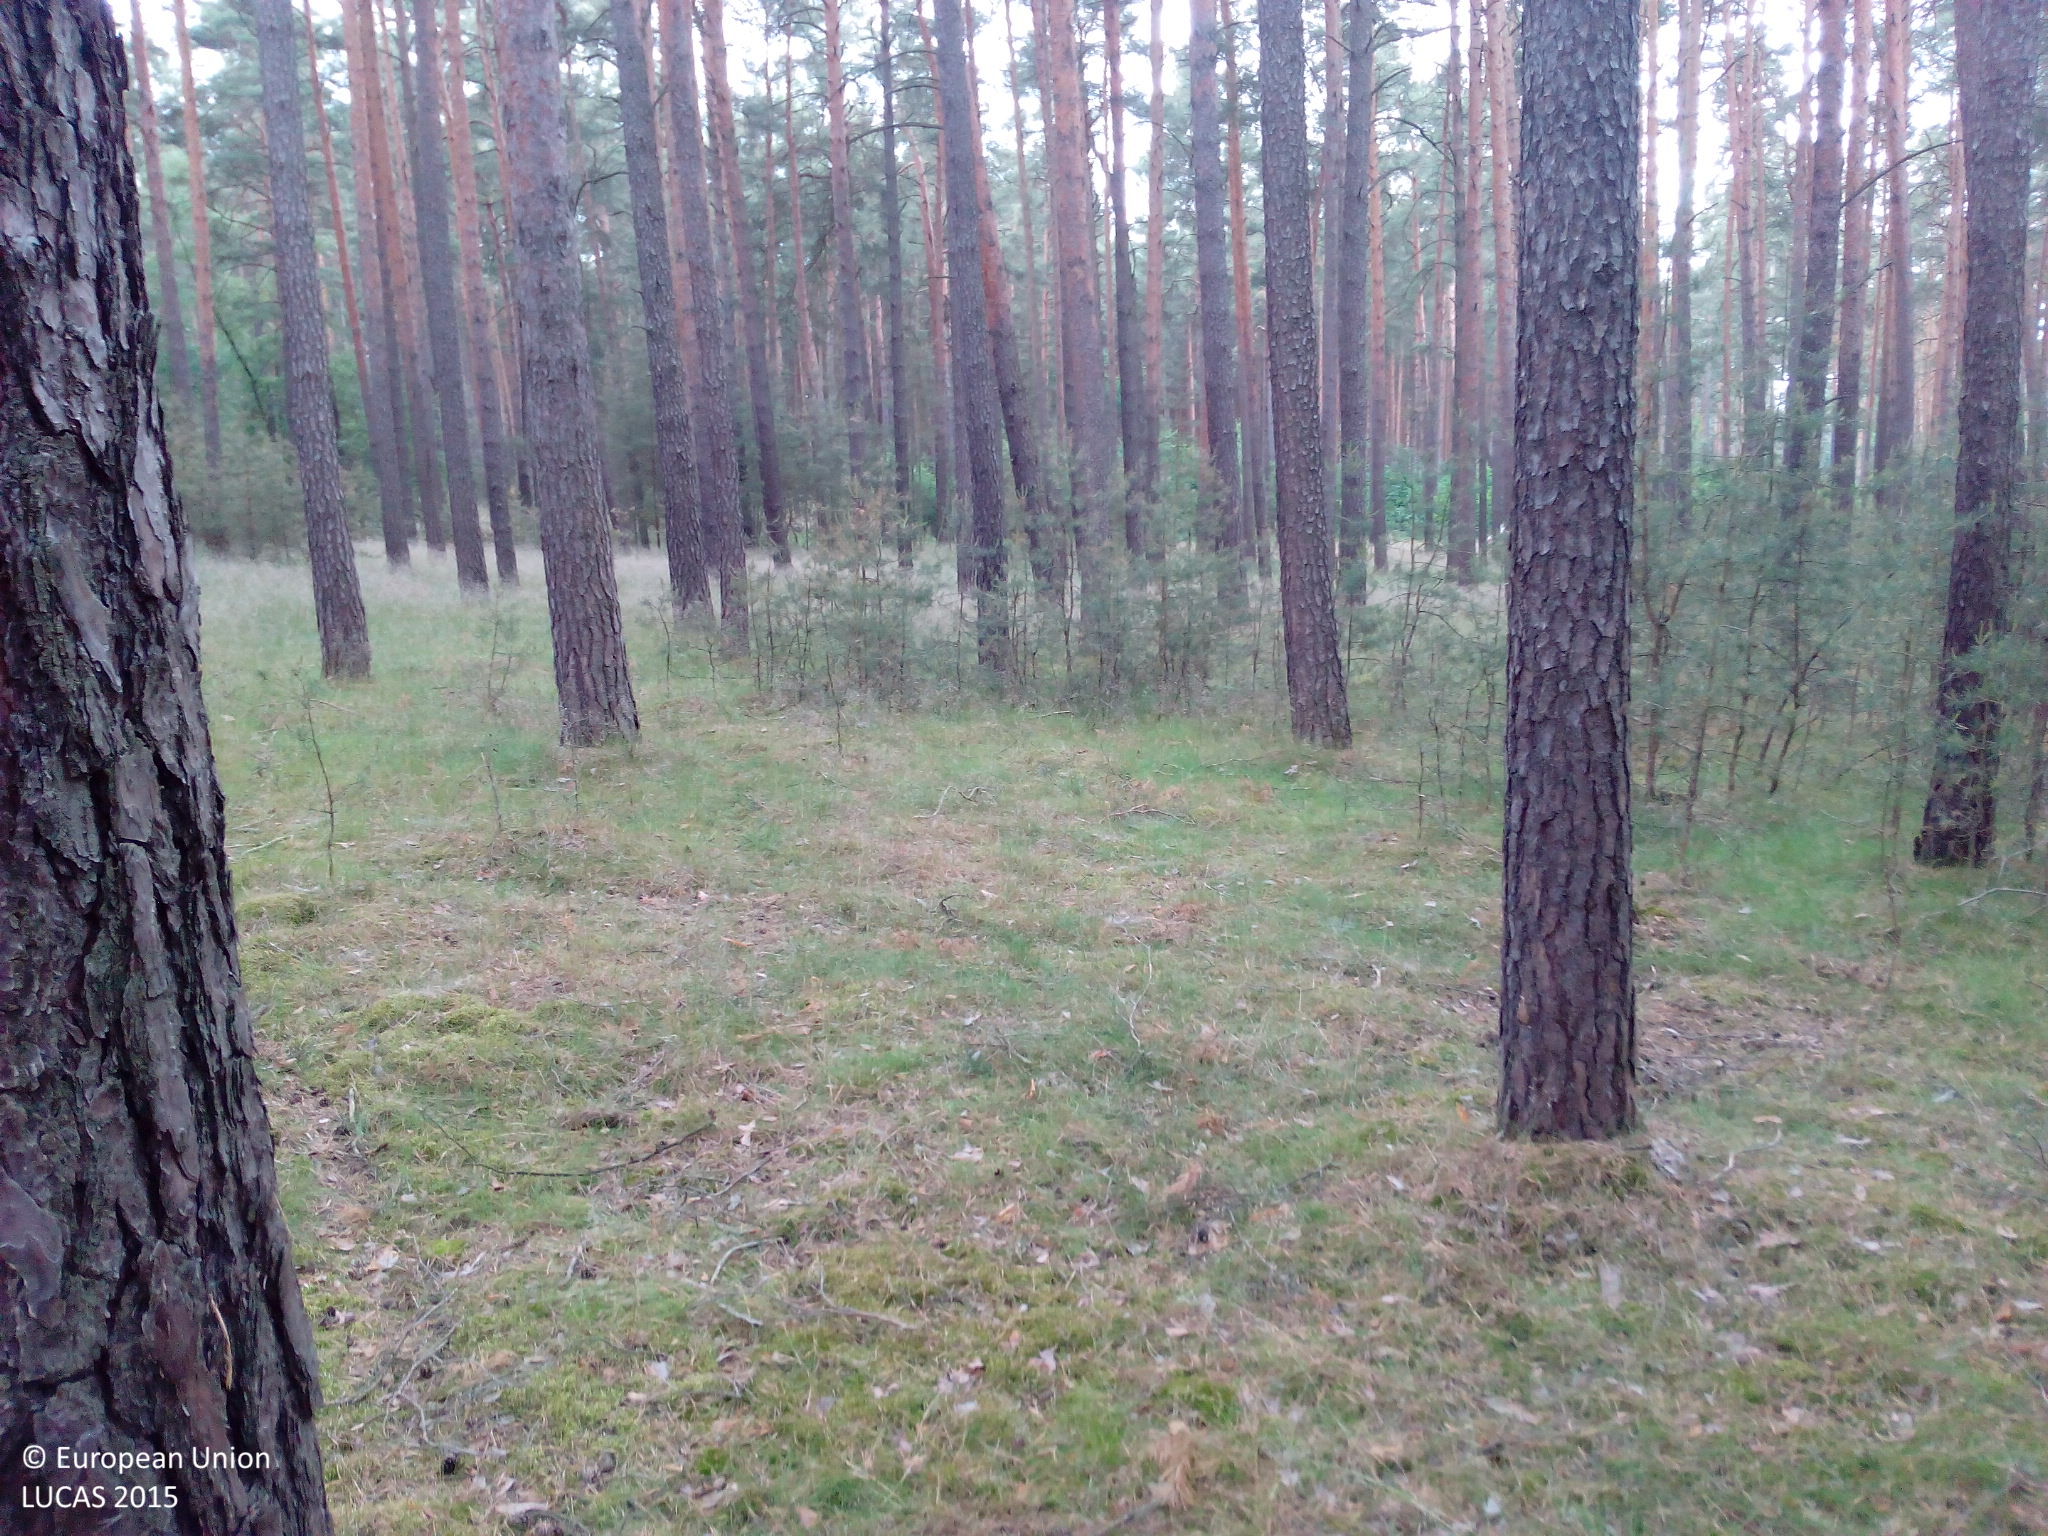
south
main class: Woodland
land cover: Pine dominated coniferous woodland
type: hemiboreal forest and nemoral coniferous forest and mixed broadleaved-coniferous forest
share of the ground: > 75 %
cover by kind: coniferous forest trees 80 %, lichens and mosses 15 %, herbaceous plants 5 %
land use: Forestry
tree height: > 5 m
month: June
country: DE
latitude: 52.2264
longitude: 12.4445
